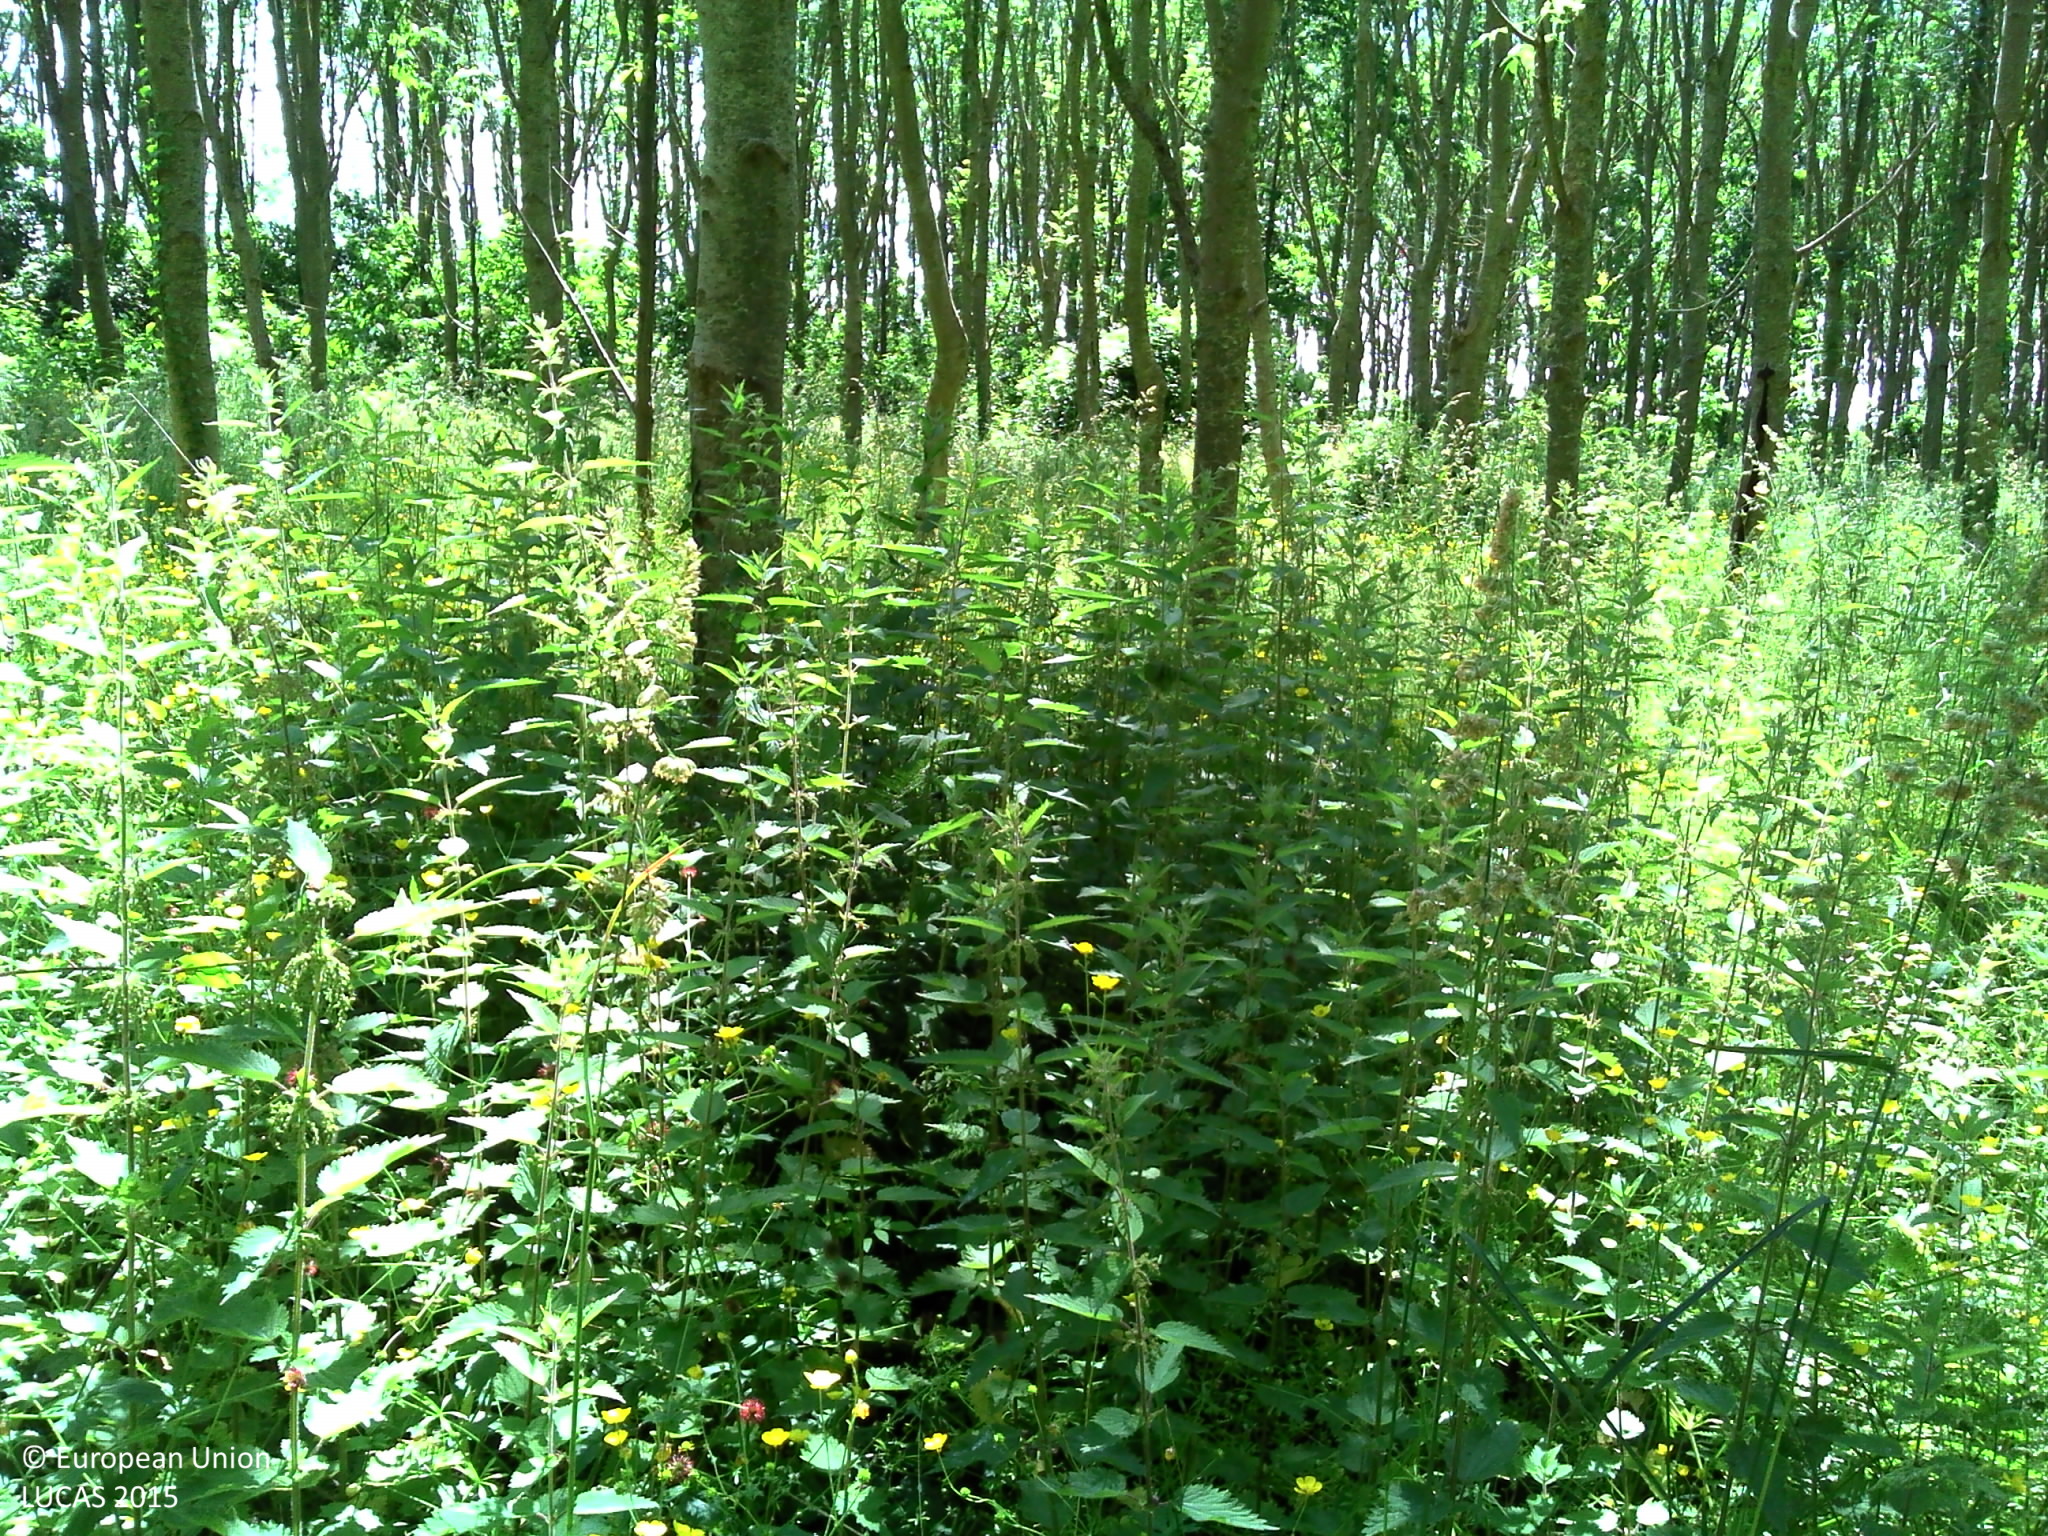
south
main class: Woodland
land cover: Broadleaved woodland
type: mesophytic deciduous forest
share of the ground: 50 - 75 %
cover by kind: broadleaved forest trees 60 %, herbaceous plants 20 %
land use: Forestry
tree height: > 5 m
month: June
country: FR
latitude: 50.7762
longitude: 2.0857
